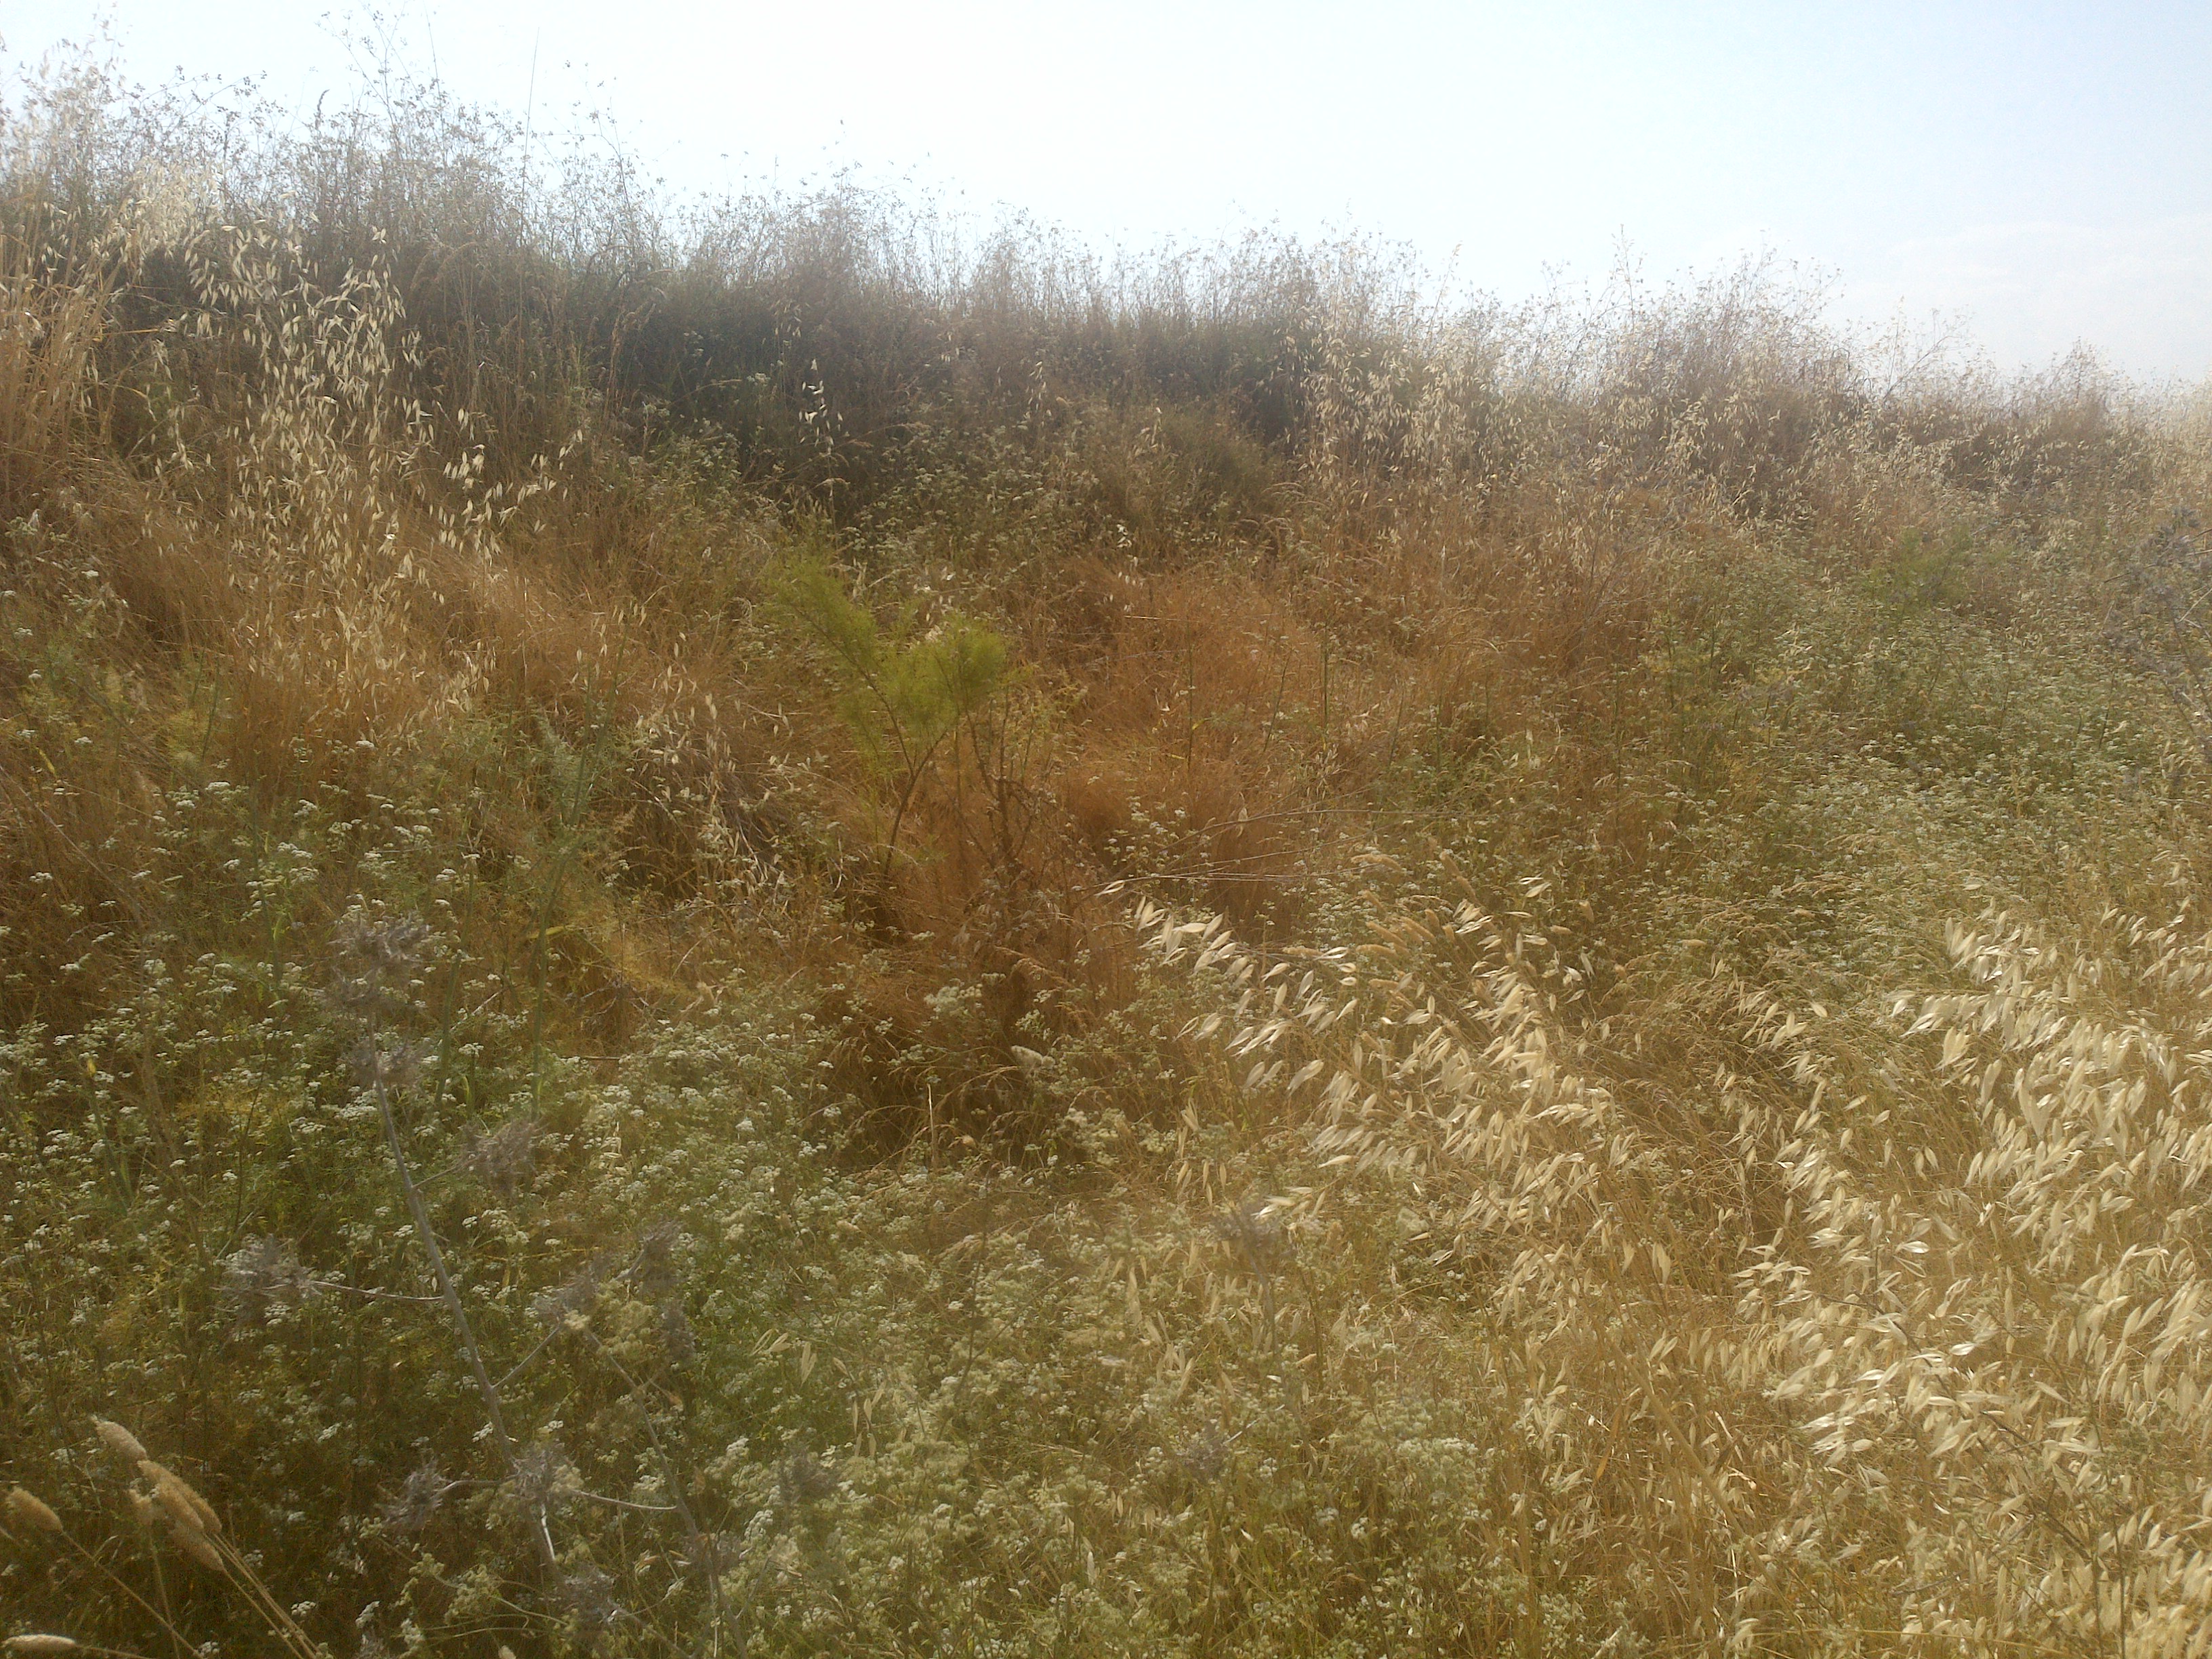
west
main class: Grassland
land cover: Grassland with sparse tree/shrub cover
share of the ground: > 75 %
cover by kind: herbaceous plants 90 %, broadleaved forest trees 5 %, unconsolidated bare surface 5 %
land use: Road transport
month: June
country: ES
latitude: 37.7596
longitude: -4.9180
